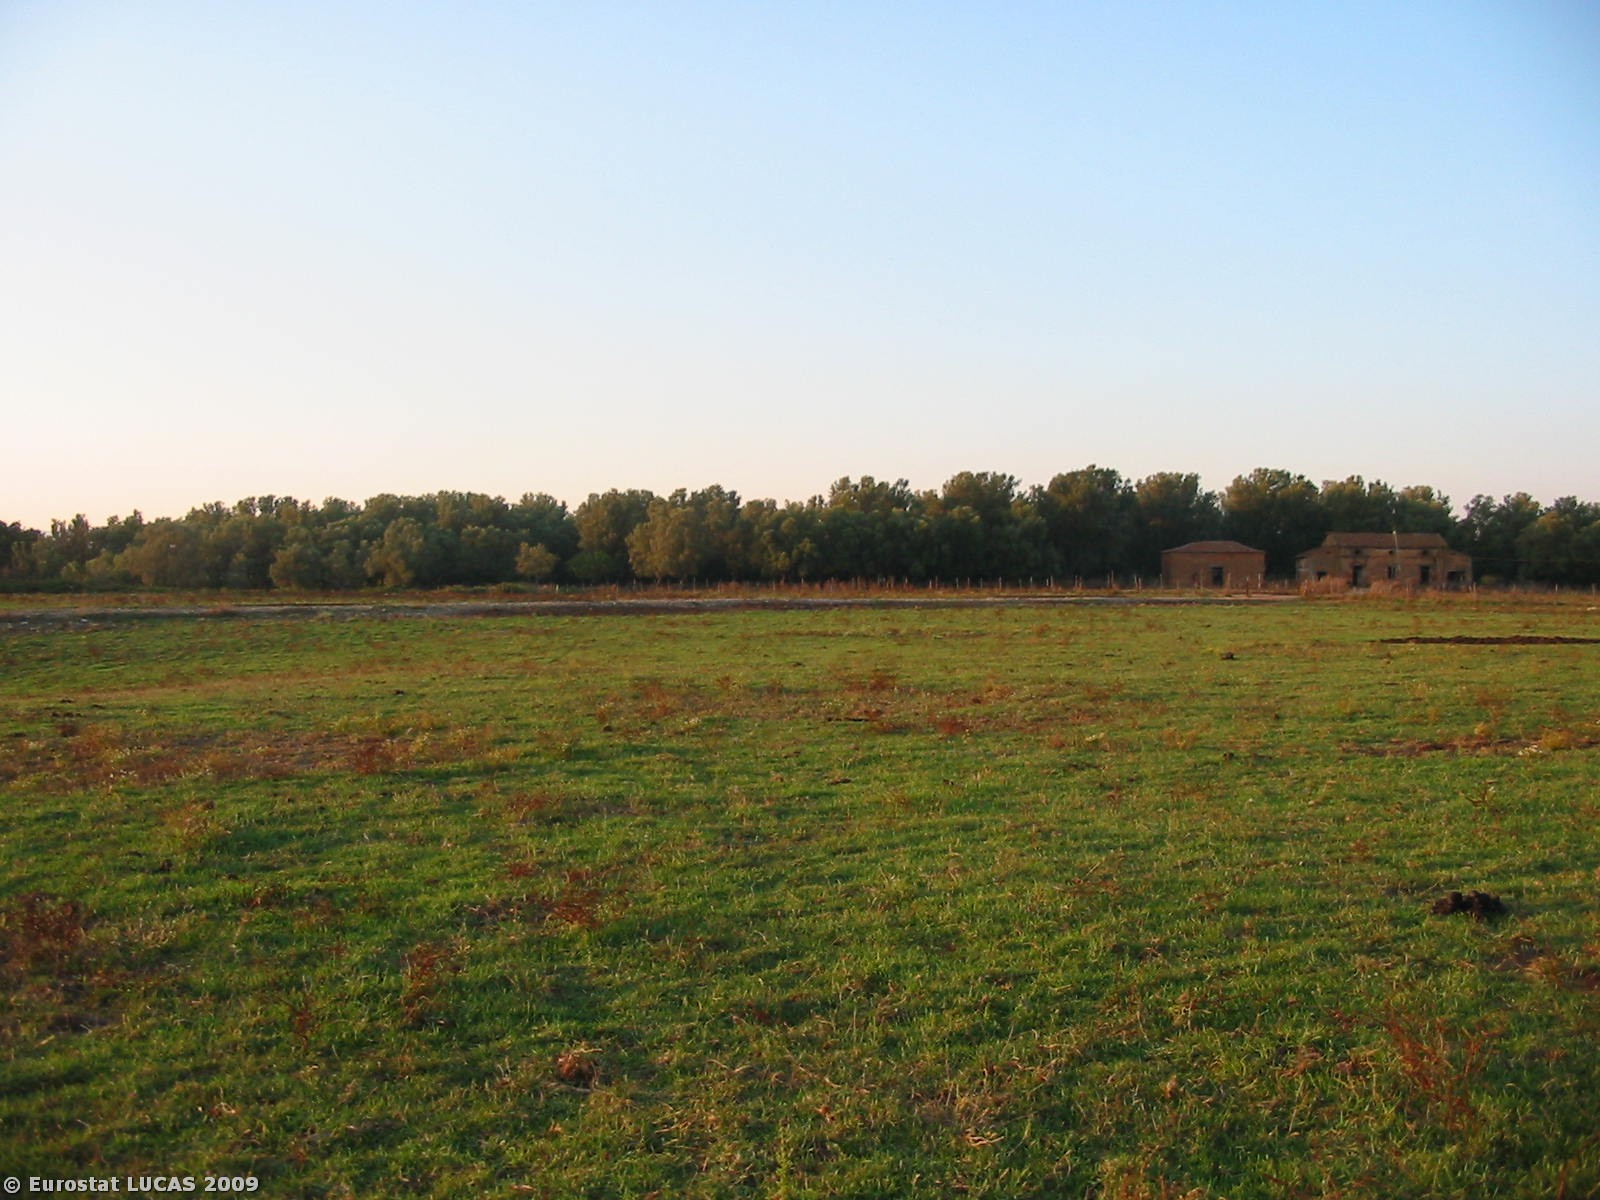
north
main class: Grassland
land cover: Grassland without tree/shrub cover
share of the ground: > 75 %
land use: Agriculture (excluding fallow land and kitchen gardens)
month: July
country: IT
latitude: 38.3975
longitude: 15.9532
